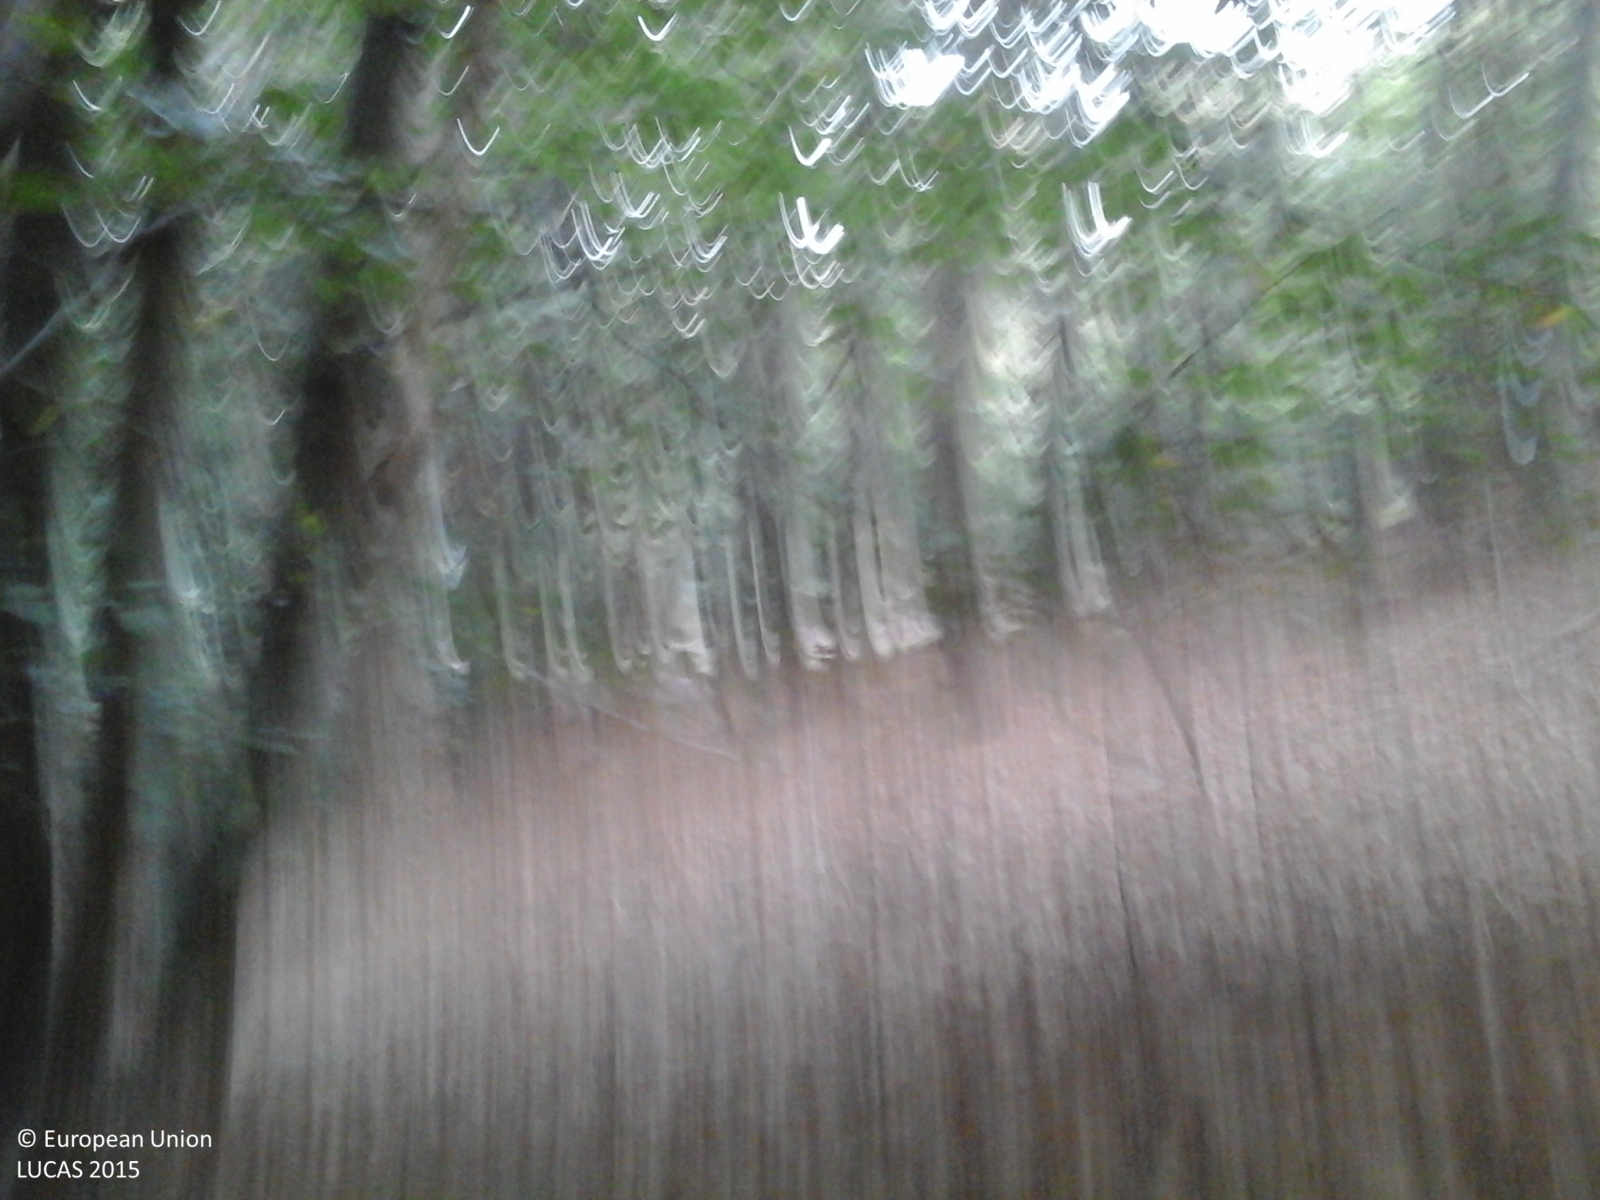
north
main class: Woodland
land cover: Broadleaved woodland
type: thermophilous deciduous forest
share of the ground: > 75 %
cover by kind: broadleaved forest trees 100 %
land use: Forestry
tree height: > 5 m
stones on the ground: 25 - 50 %
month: September
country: IT
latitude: 44.3192
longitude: 8.3362
